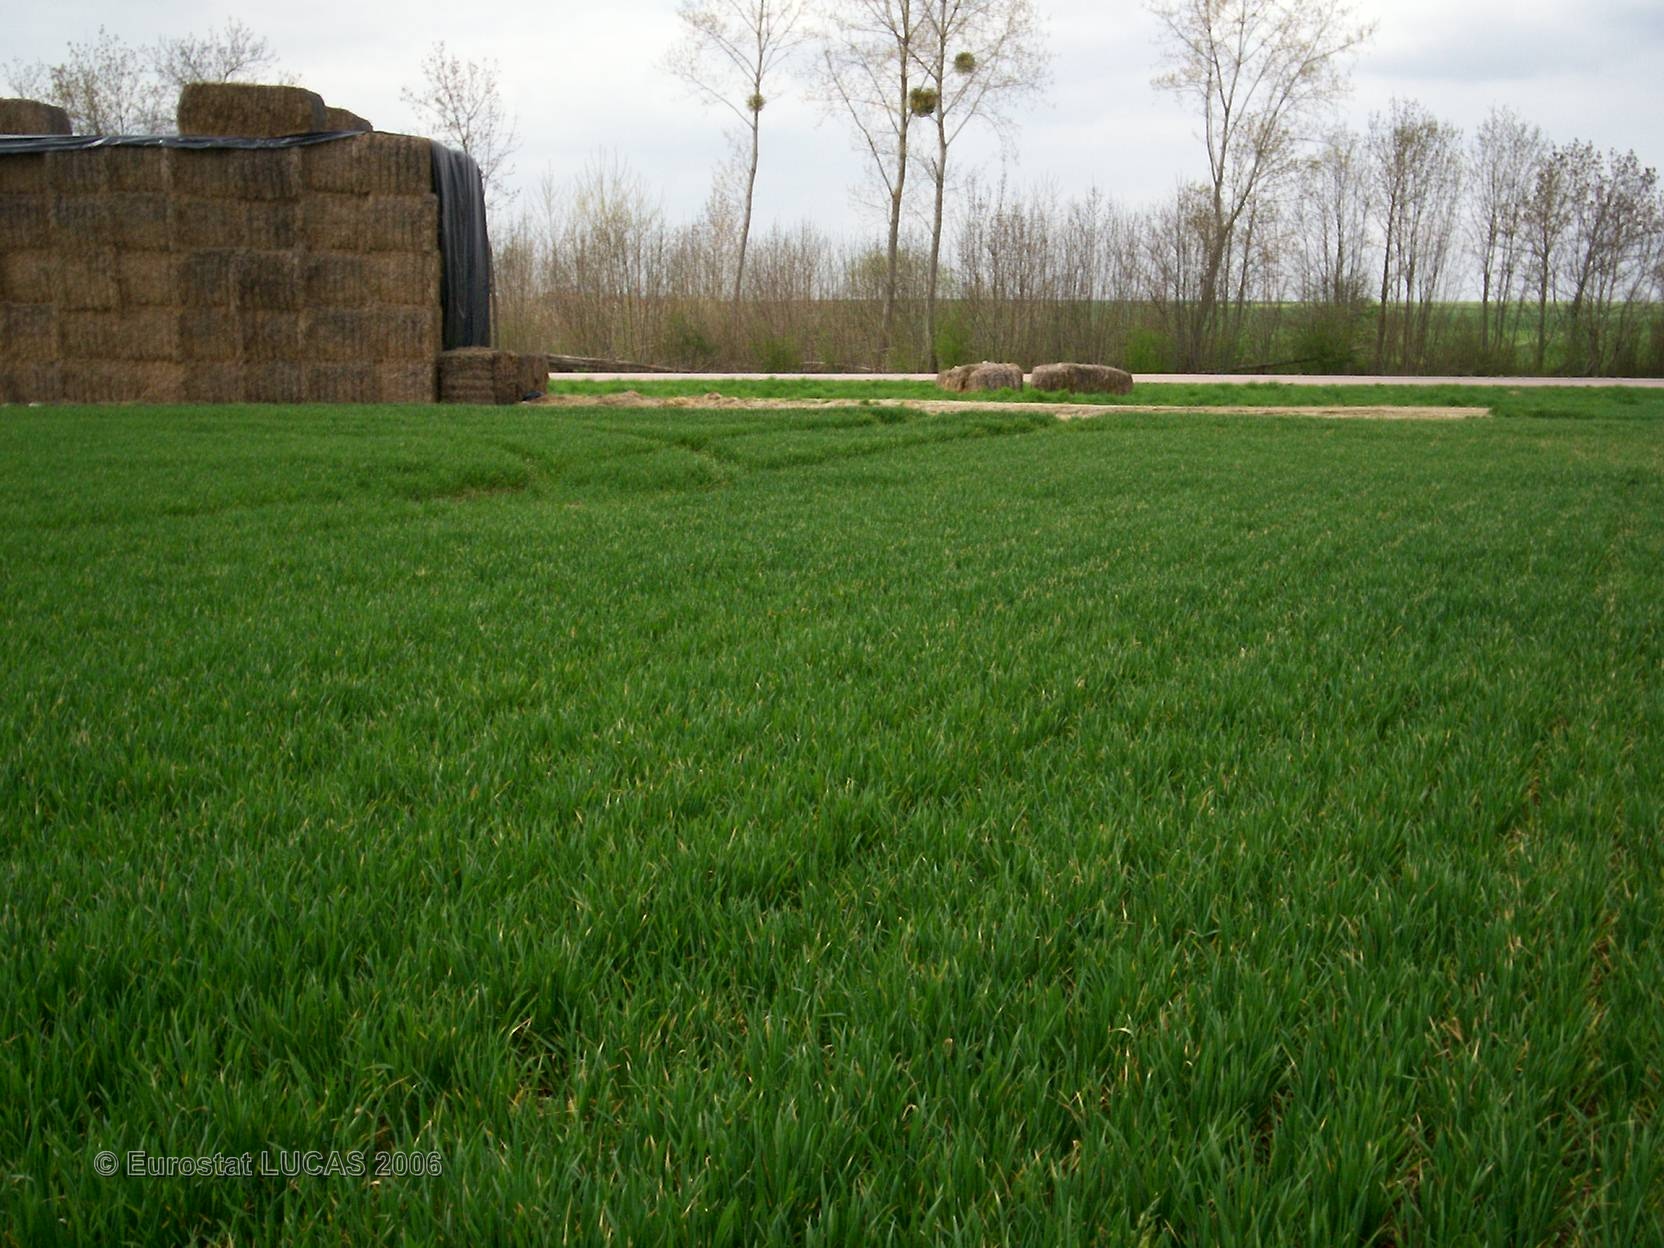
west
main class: Cropland
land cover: Common wheat
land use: Agriculture (excluding fallow land and kitchen gardens)
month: April
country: FR
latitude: 48.5005
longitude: 4.4889
